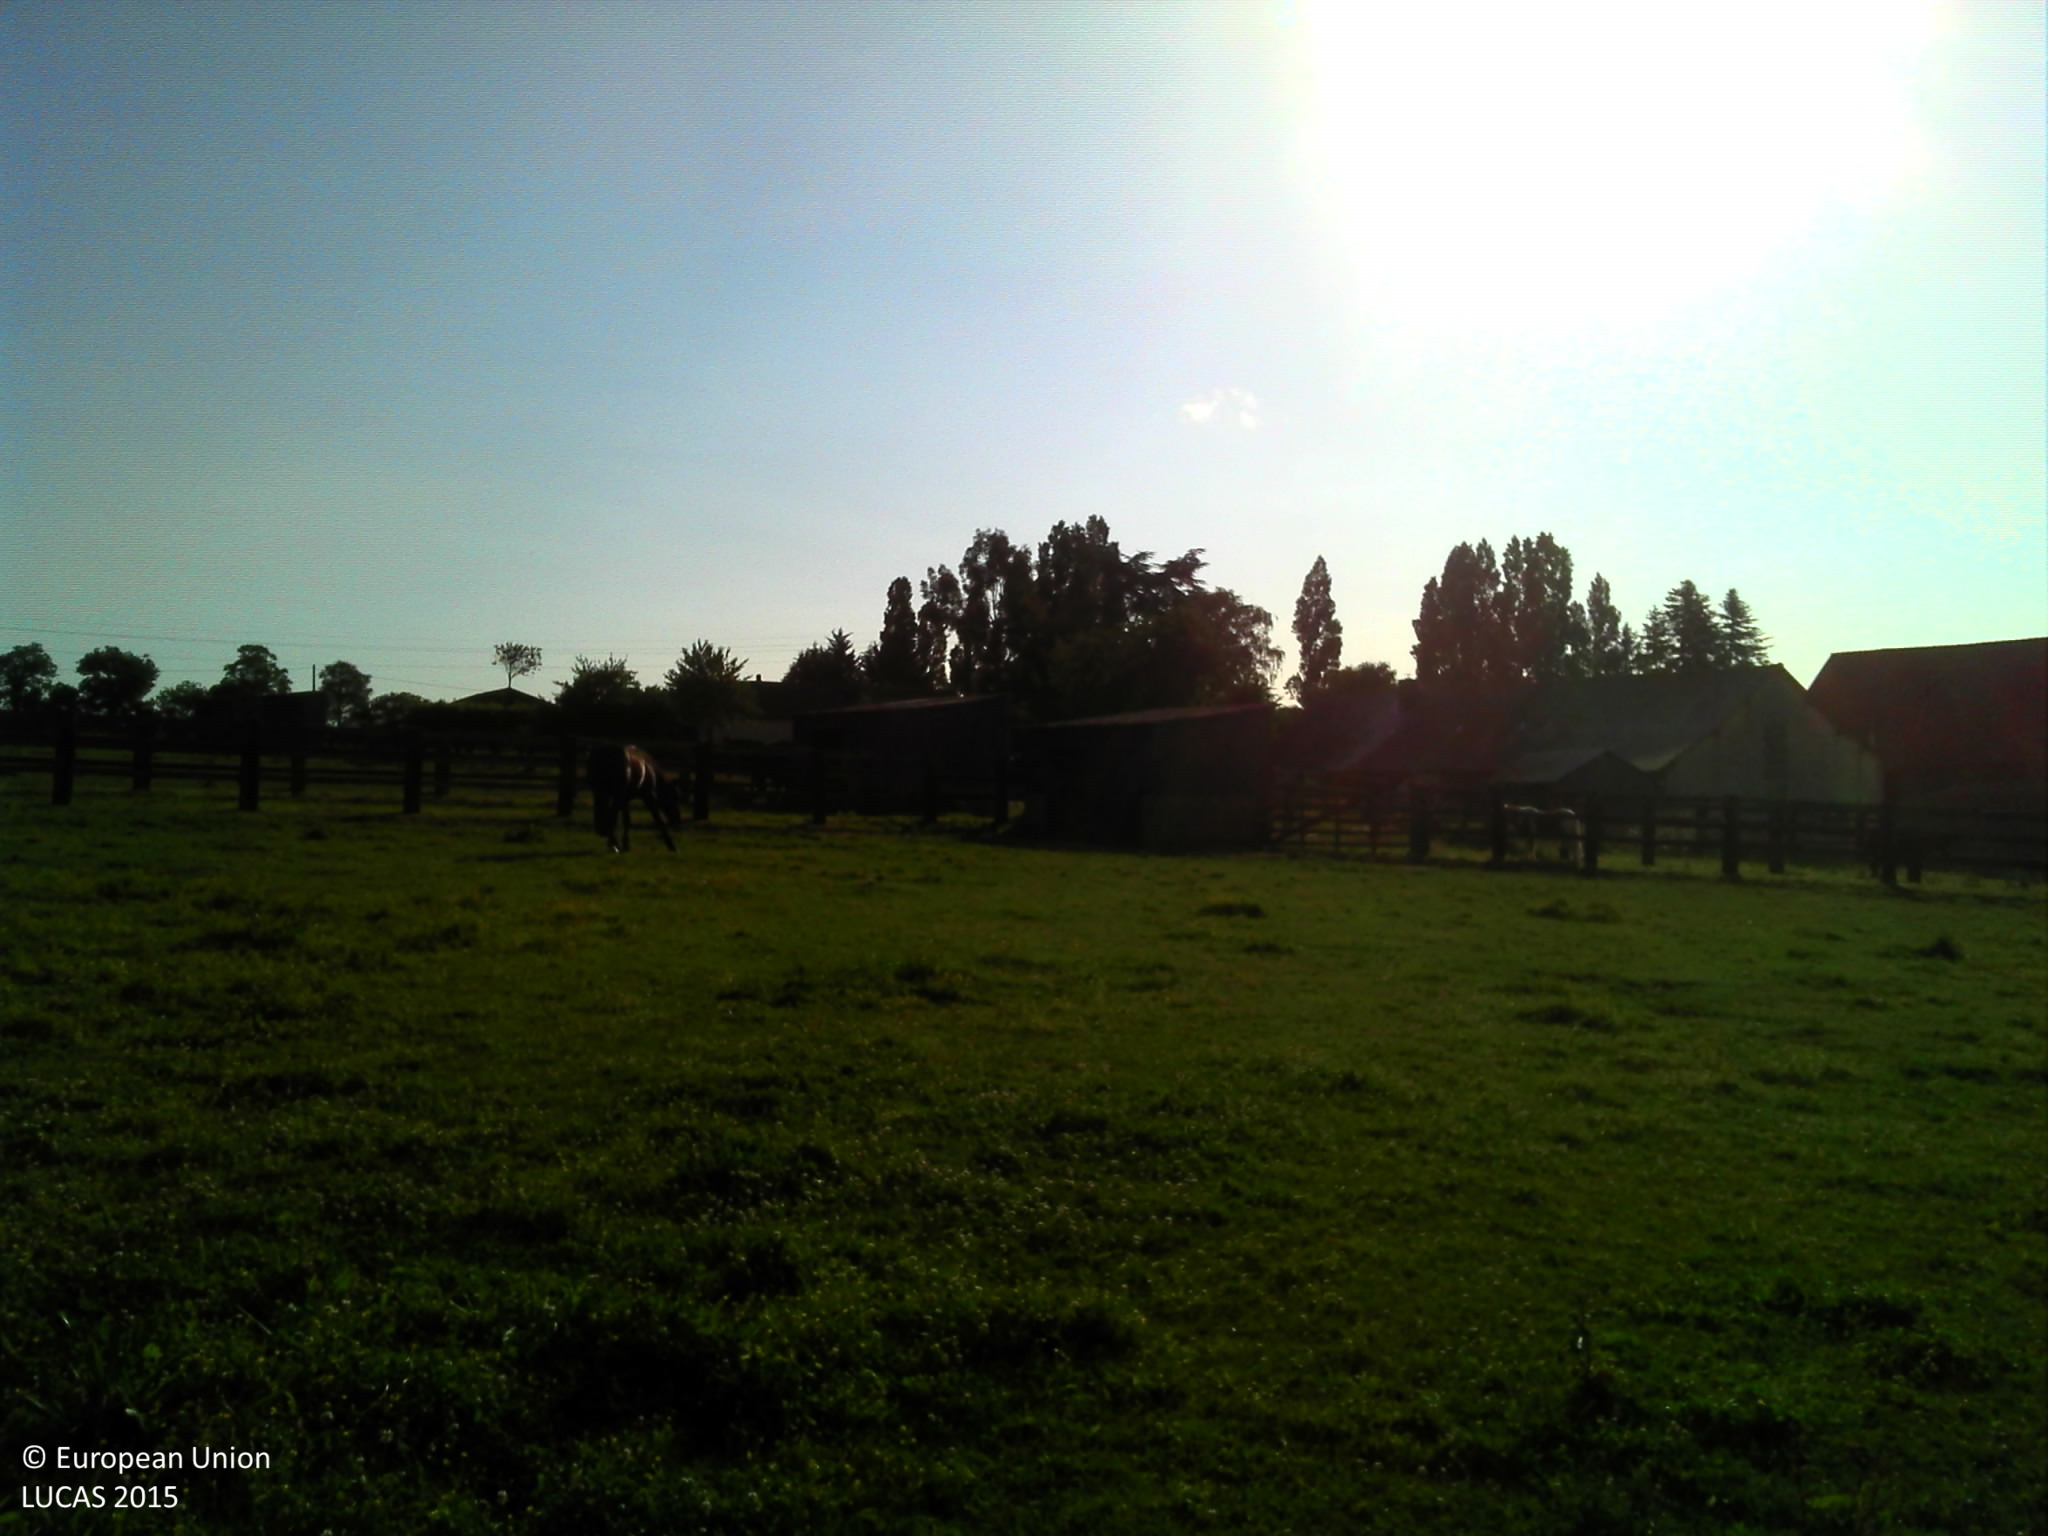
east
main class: Grassland
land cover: Grassland without tree/shrub cover
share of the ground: > 75 %
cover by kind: herbaceous plants 100 %
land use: Sport
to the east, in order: Grassland without tree/shrub cover; Fences; Tracks; Artificial constructions in urban areas; Grassland with sparse tree/shrub cover; Fences; Tracks; Fences; Grassland without tree/shrub cover; Fences; Electric lines; Ditches and canals; Grass margins; Paved roads, cycling and walking lanes; Grass margins; Ditches and canals; Fences; Grassland without tree/shrub cover
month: June
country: FR
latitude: 48.0870
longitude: -1.1979
